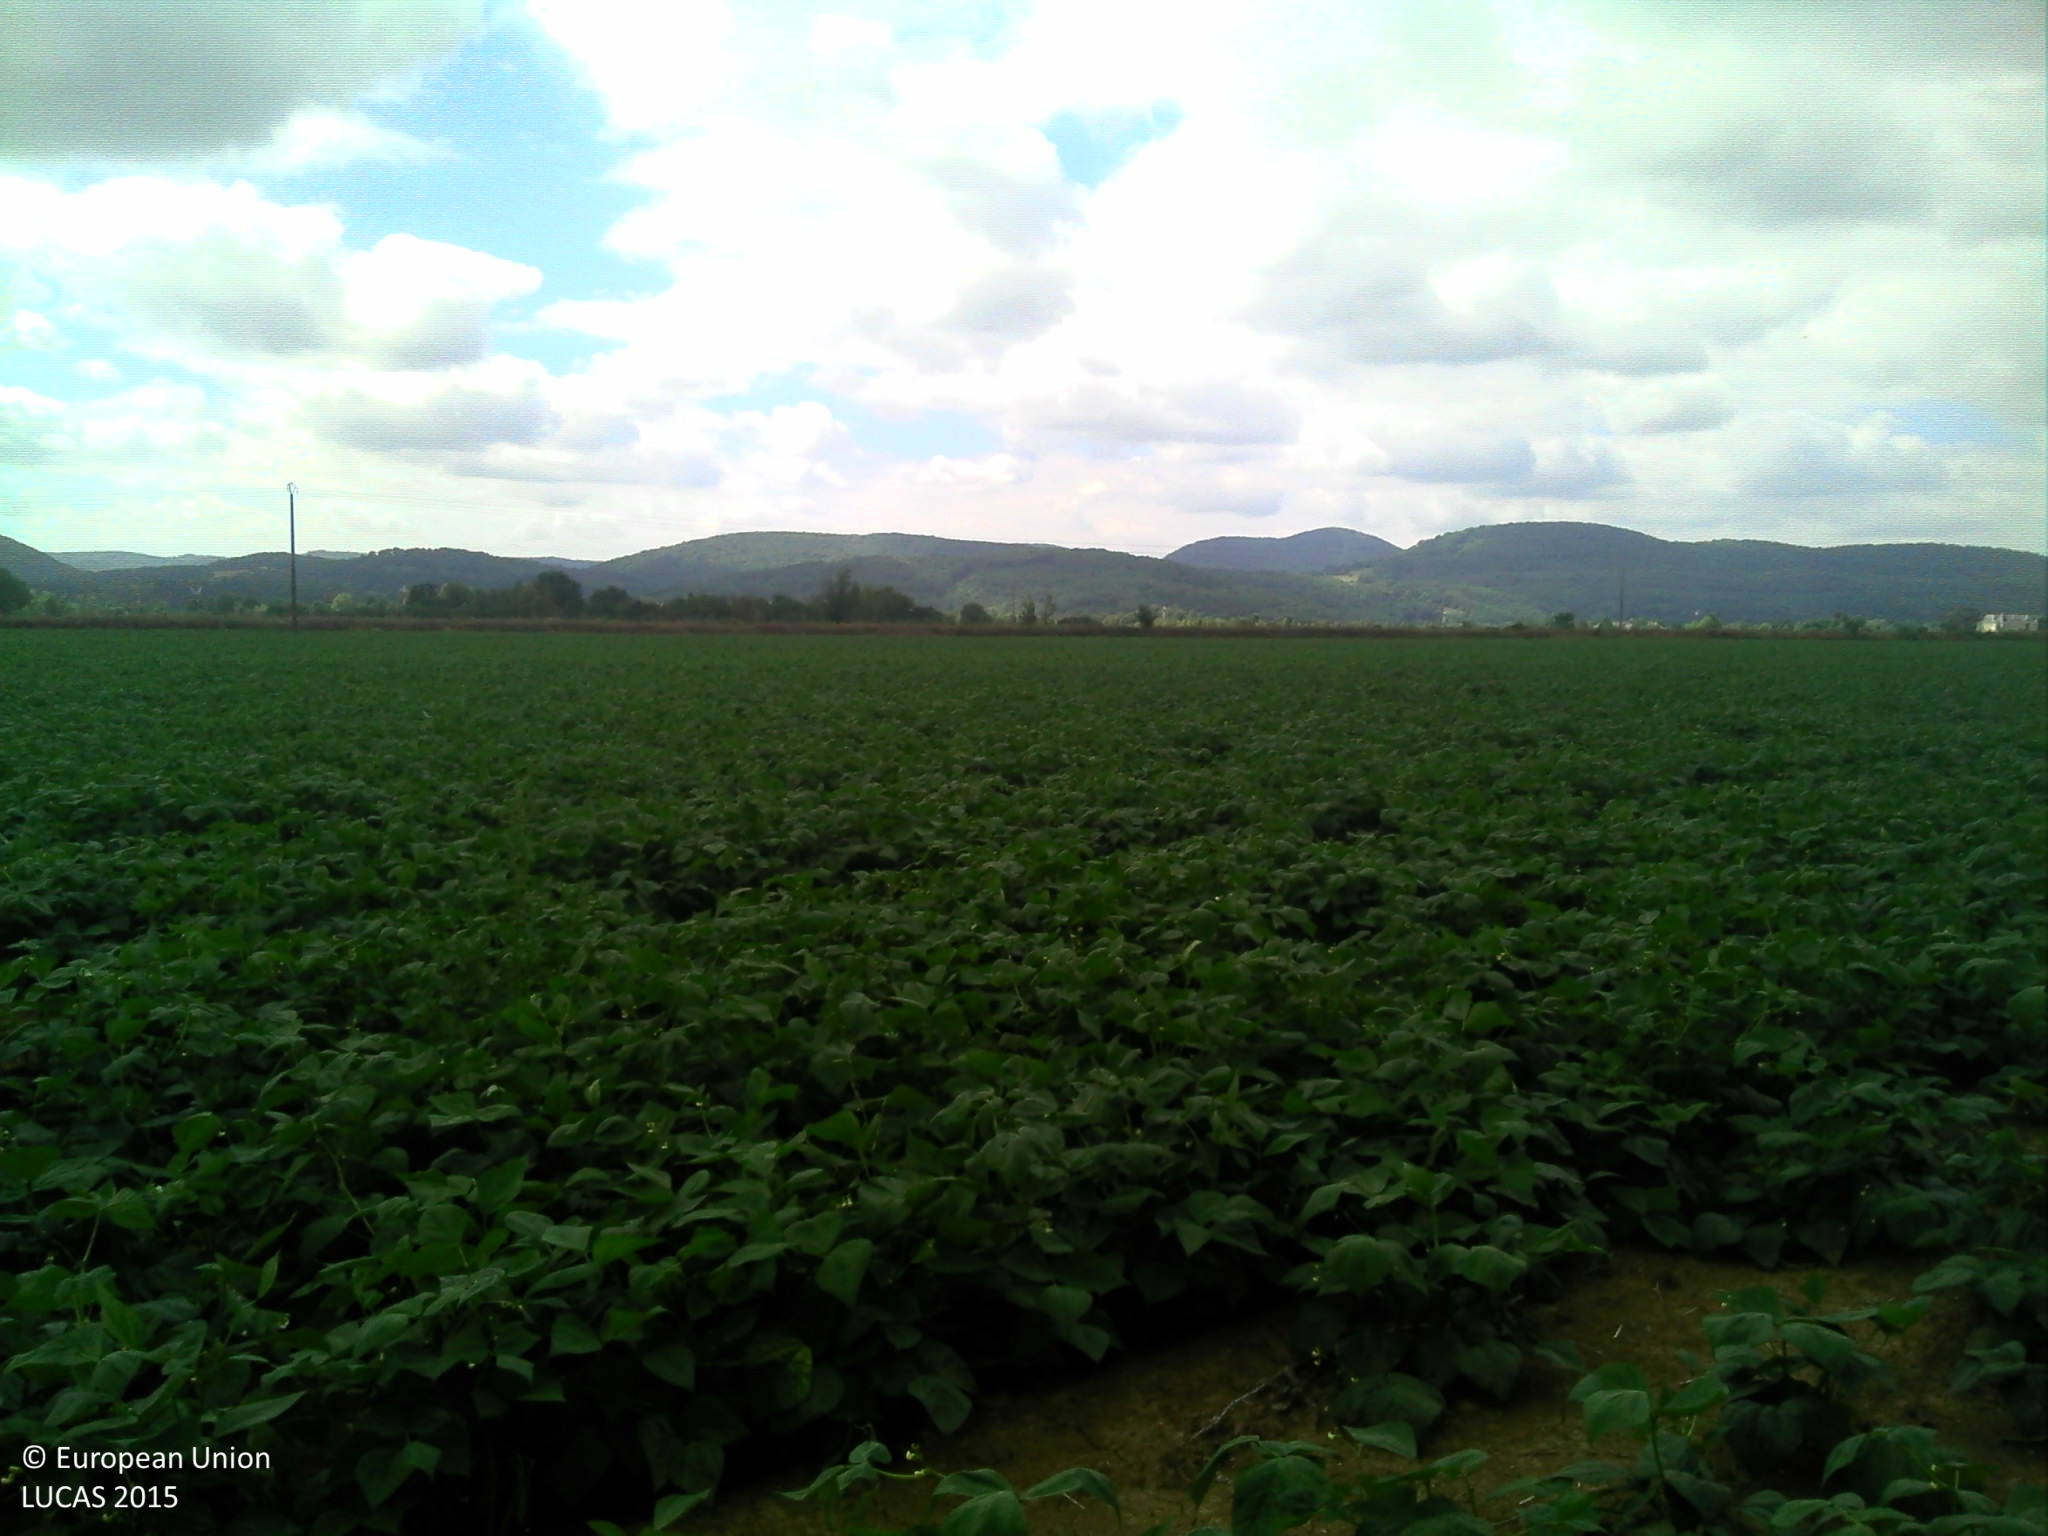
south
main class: Cropland
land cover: Other fresh vegetables
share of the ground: > 75 %
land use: Agriculture (excluding fallow land and kitchen gardens)
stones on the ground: < 10 %
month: July
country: FR
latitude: 43.2196
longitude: 1.0531
